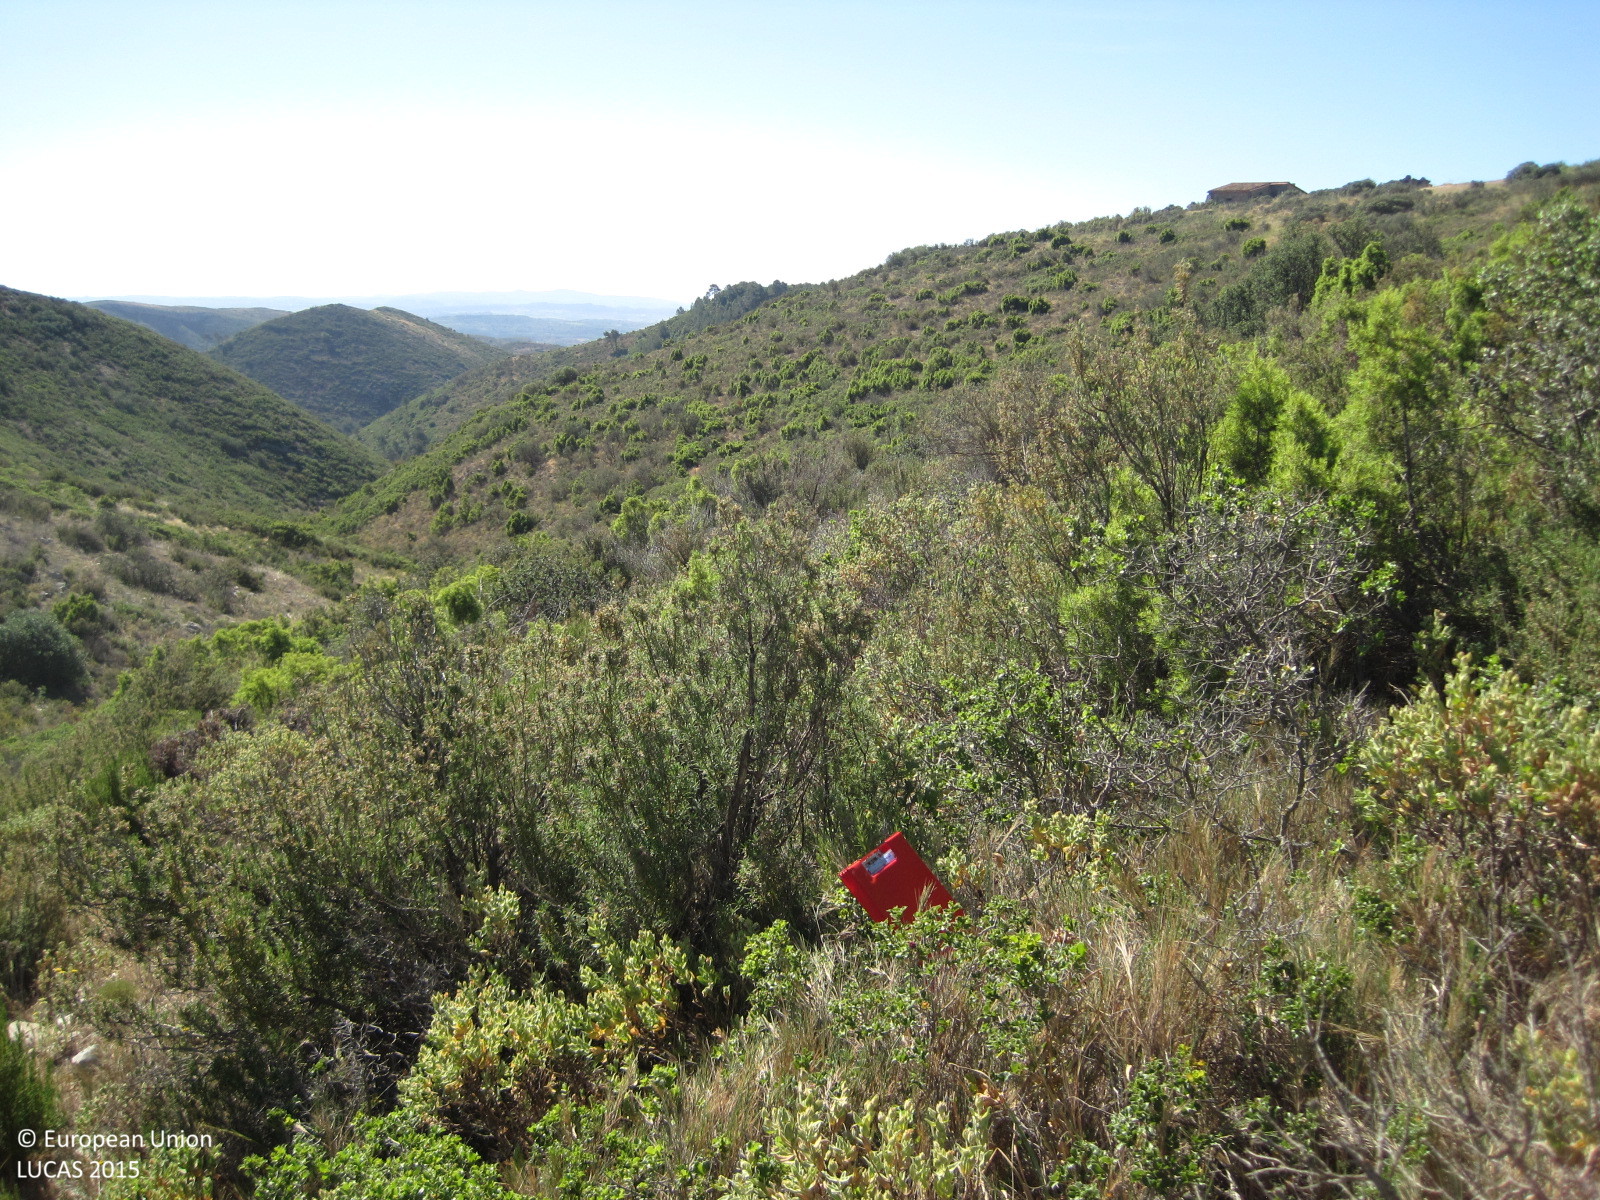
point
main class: Woodland
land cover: Broadleaved woodland
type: acidophilous oak and oak-birch forest
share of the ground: 10 - 25 %
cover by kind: shrubs 80 %, broadleaved forest trees 10 %, herbaceous plants 5 %, consolidated bare surface 5 %
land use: Semi-natural and natural areas not in use
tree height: < 5 m
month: May
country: ES
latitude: 39.4663
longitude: -0.8208
